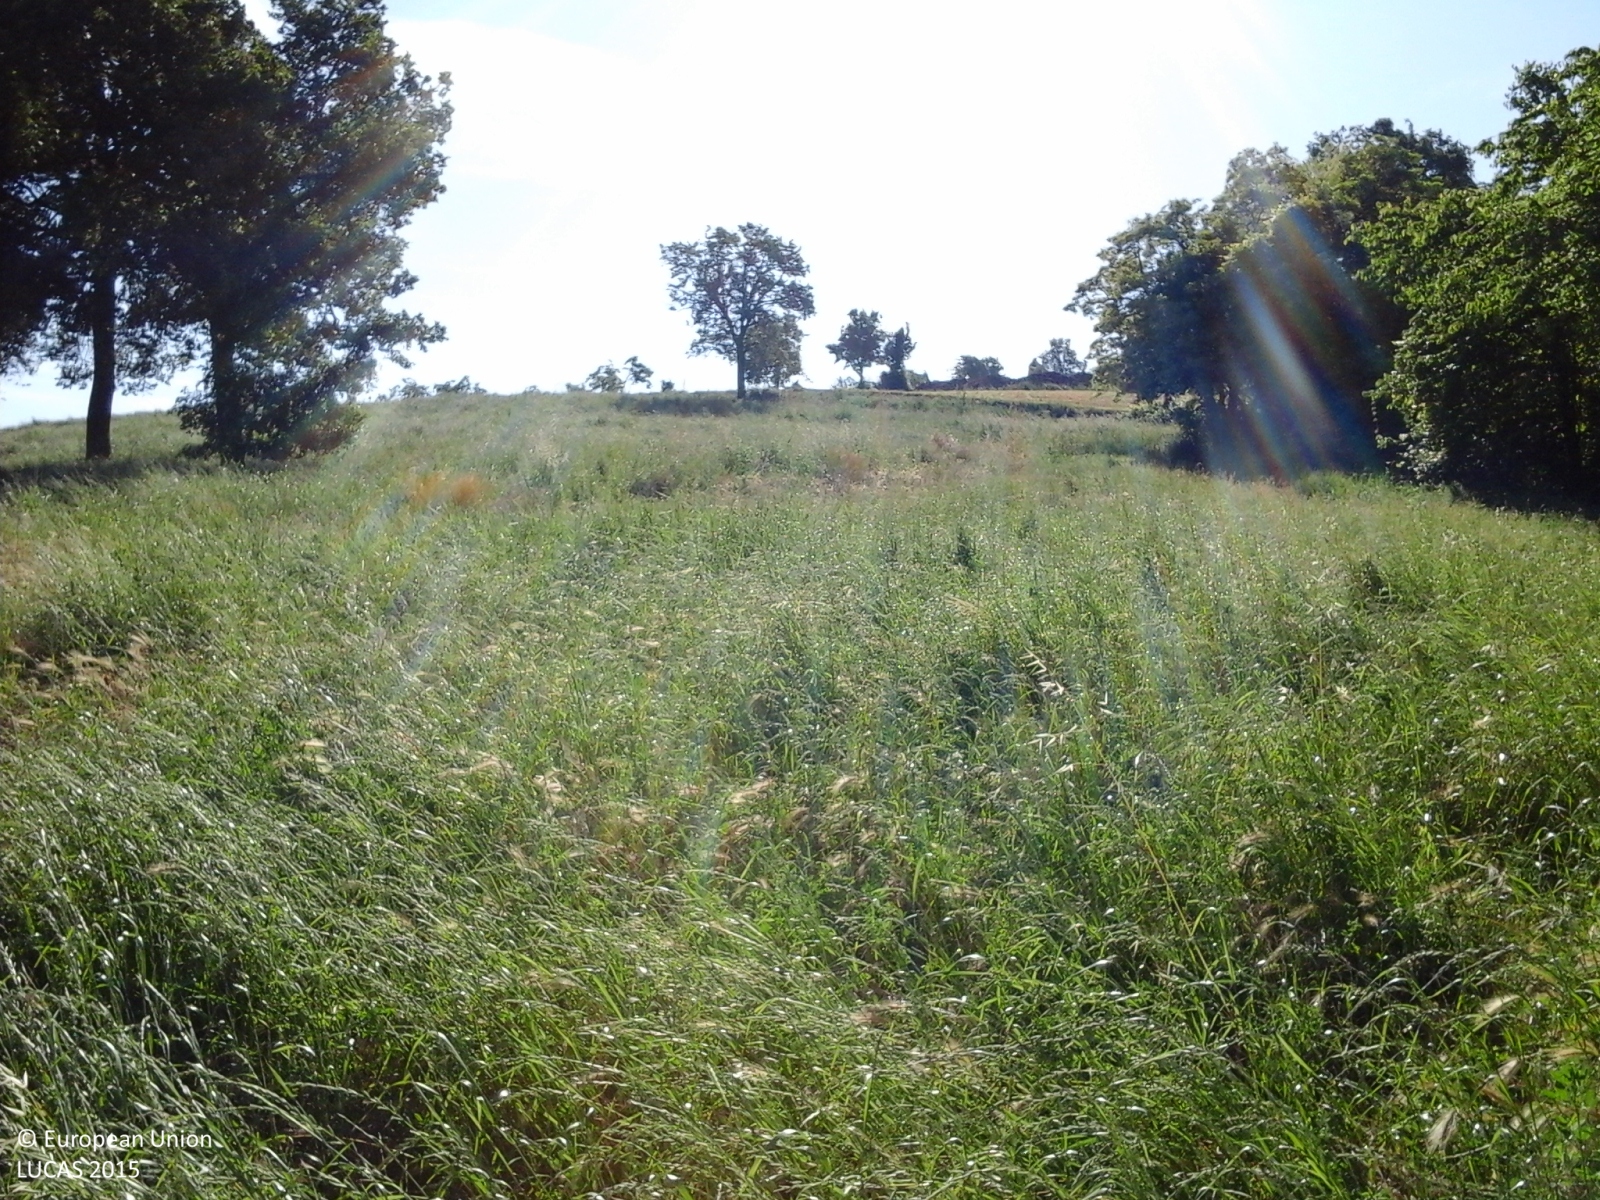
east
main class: Cropland
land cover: Lucerne
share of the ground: > 75 %
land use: Agriculture (excluding fallow land and kitchen gardens)
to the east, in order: Lucerne; Tracks; Single bushes/trees; Lucerne; Abandoned hedges; Paved roads, cycling and walking lanes; Lucerne; Electric lines; Lucerne; Single bushes/trees; Lucerne
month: May
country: IT
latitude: 44.4566
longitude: 10.6646
